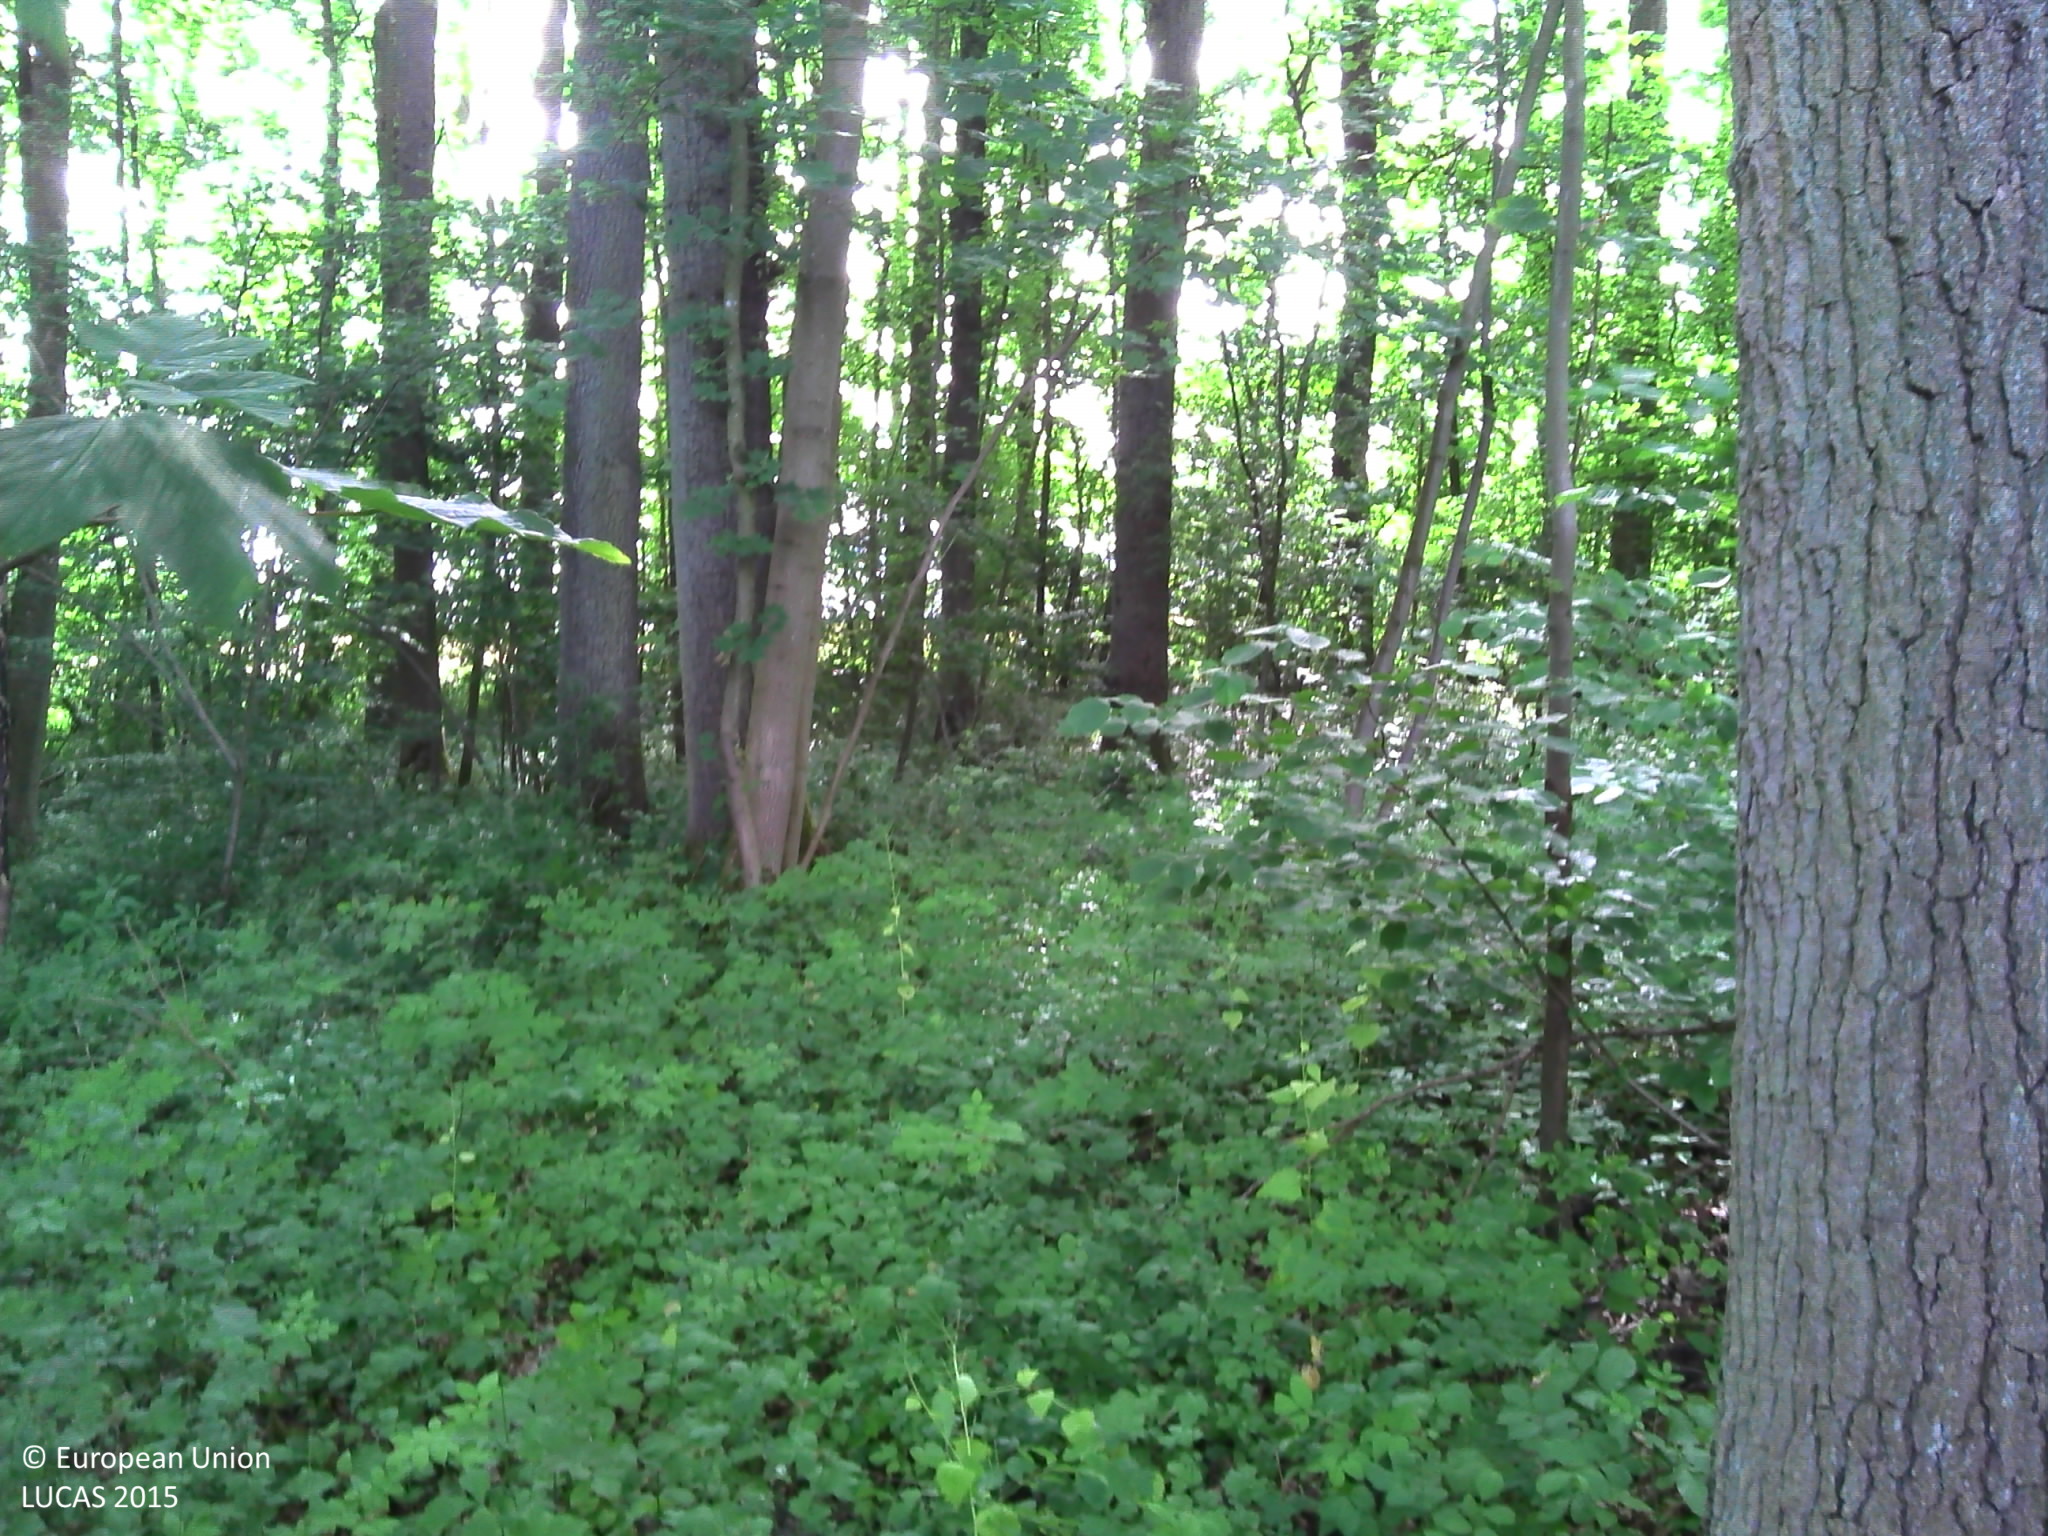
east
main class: Woodland
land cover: Broadleaved woodland
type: mesophytic deciduous forest
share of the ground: > 75 %
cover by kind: broadleaved forest trees 100 %
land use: Forestry
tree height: > 5 m
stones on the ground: < 10 %
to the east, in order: Broadleaved woodland; Fences; Grassland without tree/shrub cover; Barley; Fences; Tracks; Other fibre and oleaginous crops
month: June
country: BE
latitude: 50.2865
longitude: 4.9023
